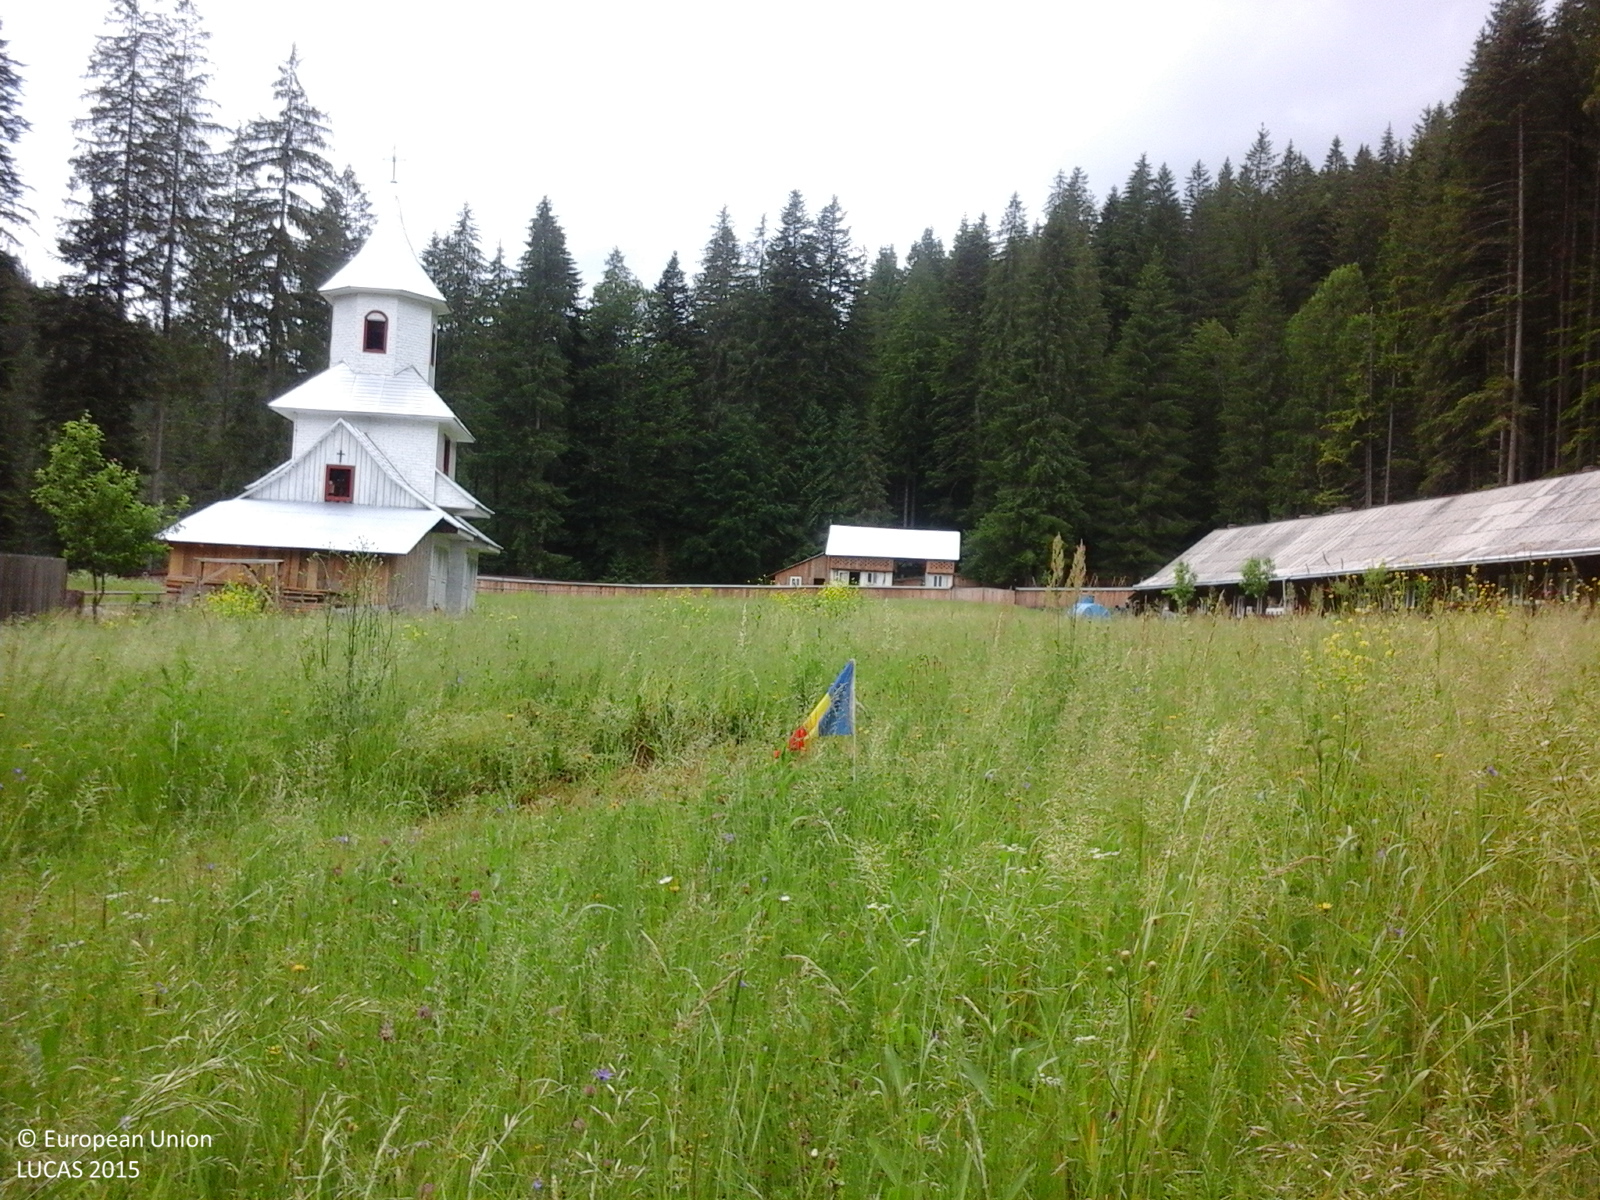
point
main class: Grassland
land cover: Grassland without tree/shrub cover
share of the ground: > 75 %
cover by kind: herbaceous plants 100 %
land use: Community services
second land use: Amenities, museums, leisure
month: June
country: RO
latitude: 46.7433
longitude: 26.0533
